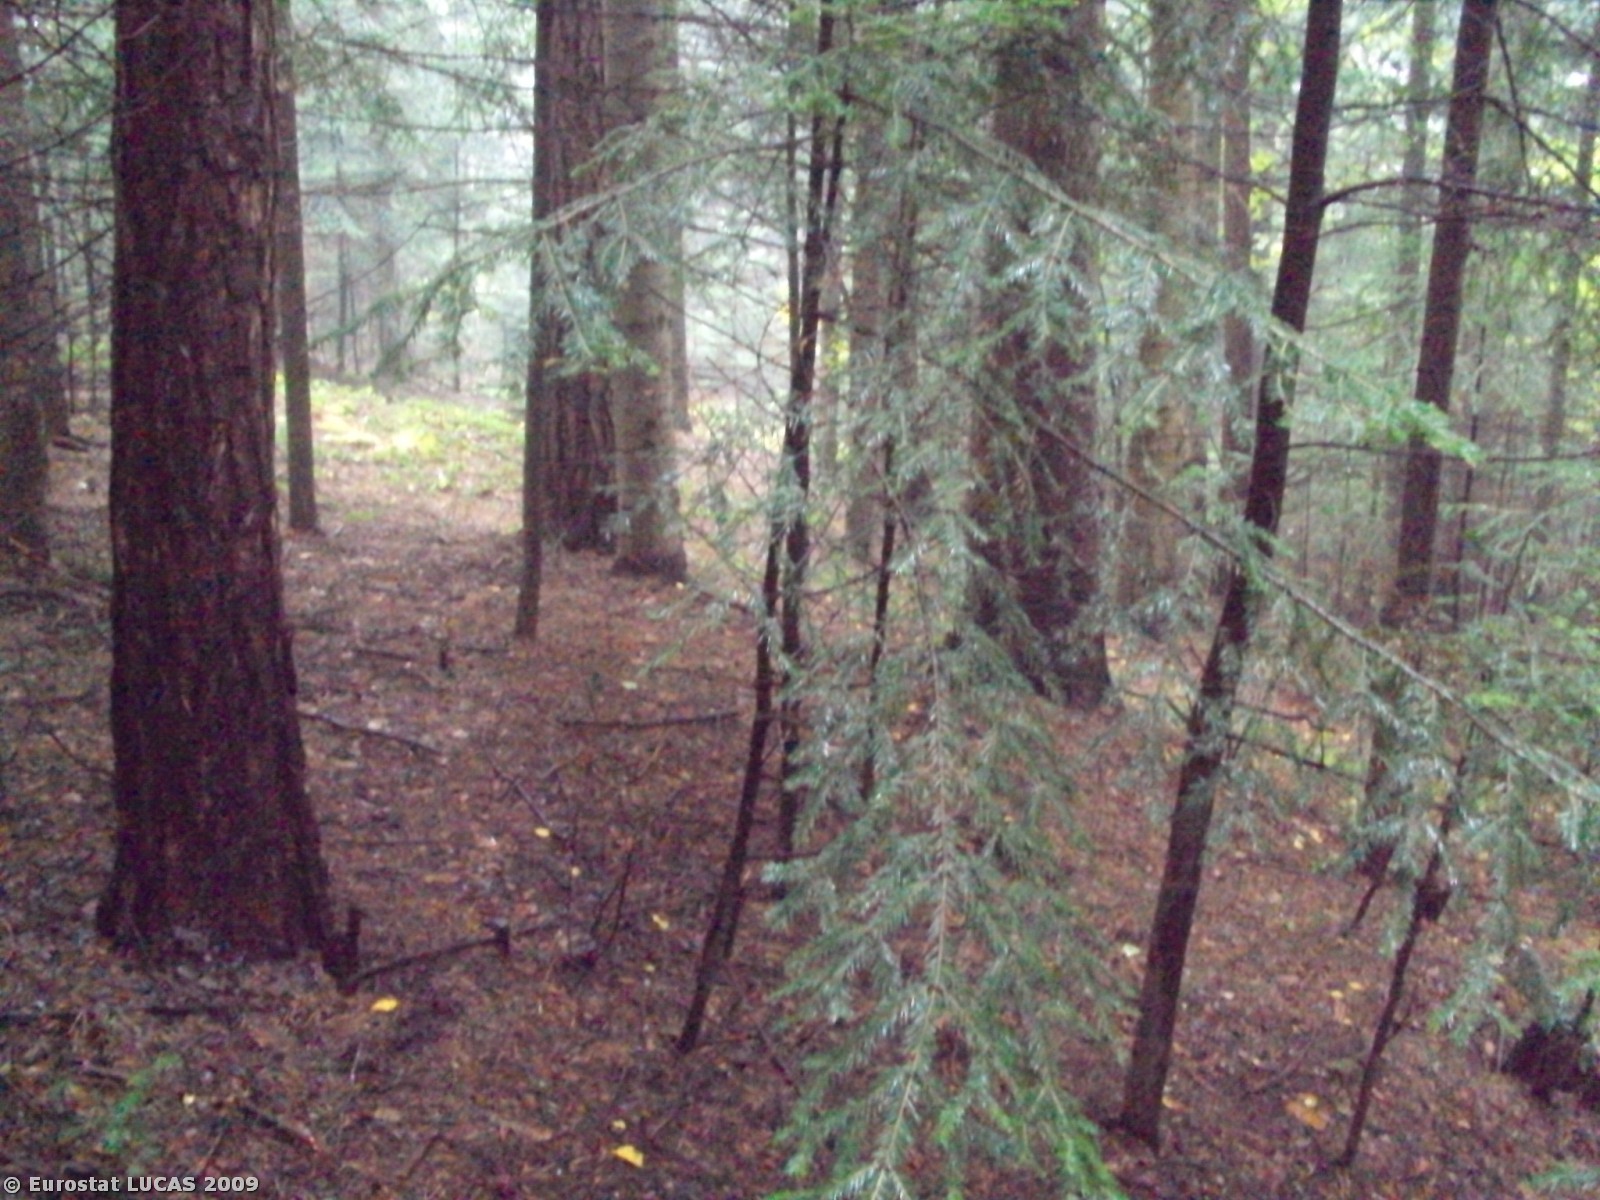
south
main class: Woodland
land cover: Coniferous woodland
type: hemiboreal forest and nemoral coniferous forest and mixed broadleaved-coniferous forest
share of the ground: > 75 %
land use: Unused
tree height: > 5 m
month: September
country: PL
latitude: 49.7304
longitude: 20.1471
